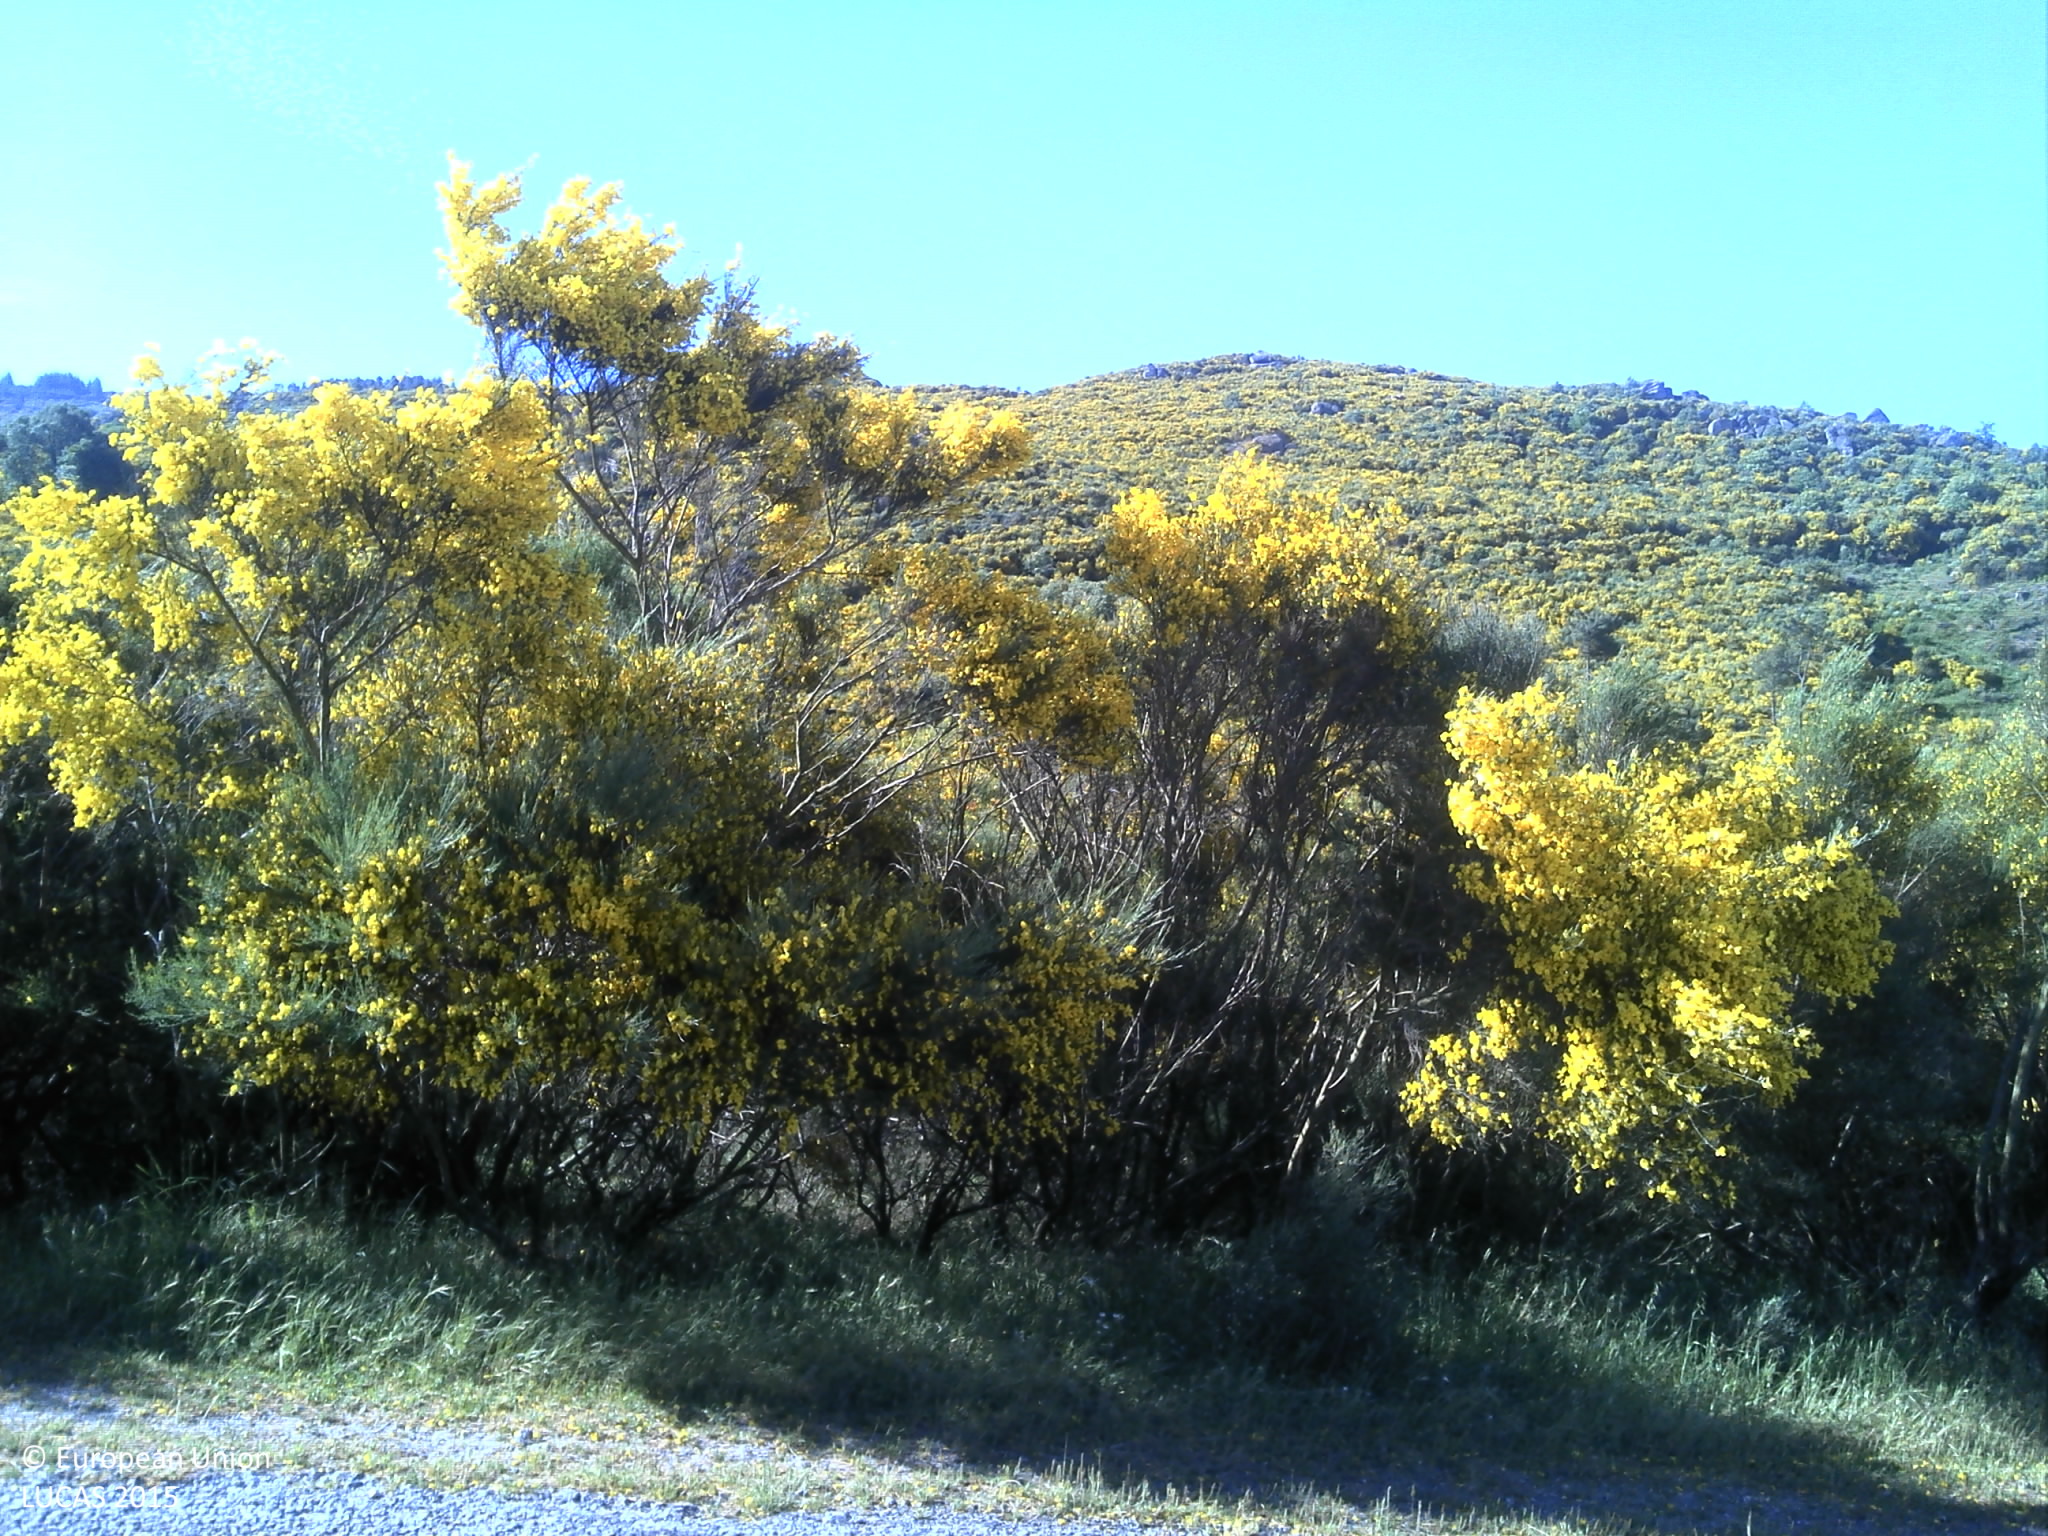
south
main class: Shrubland
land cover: Shrubland without tree cover
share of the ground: 50 - 75 %
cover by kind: shrubs 70 %, herbaceous plants 10 %, unconsolidated bare surface 10 %
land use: Semi-natural and natural areas not in use
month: May
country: PT
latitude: 40.5563
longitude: -7.4351
